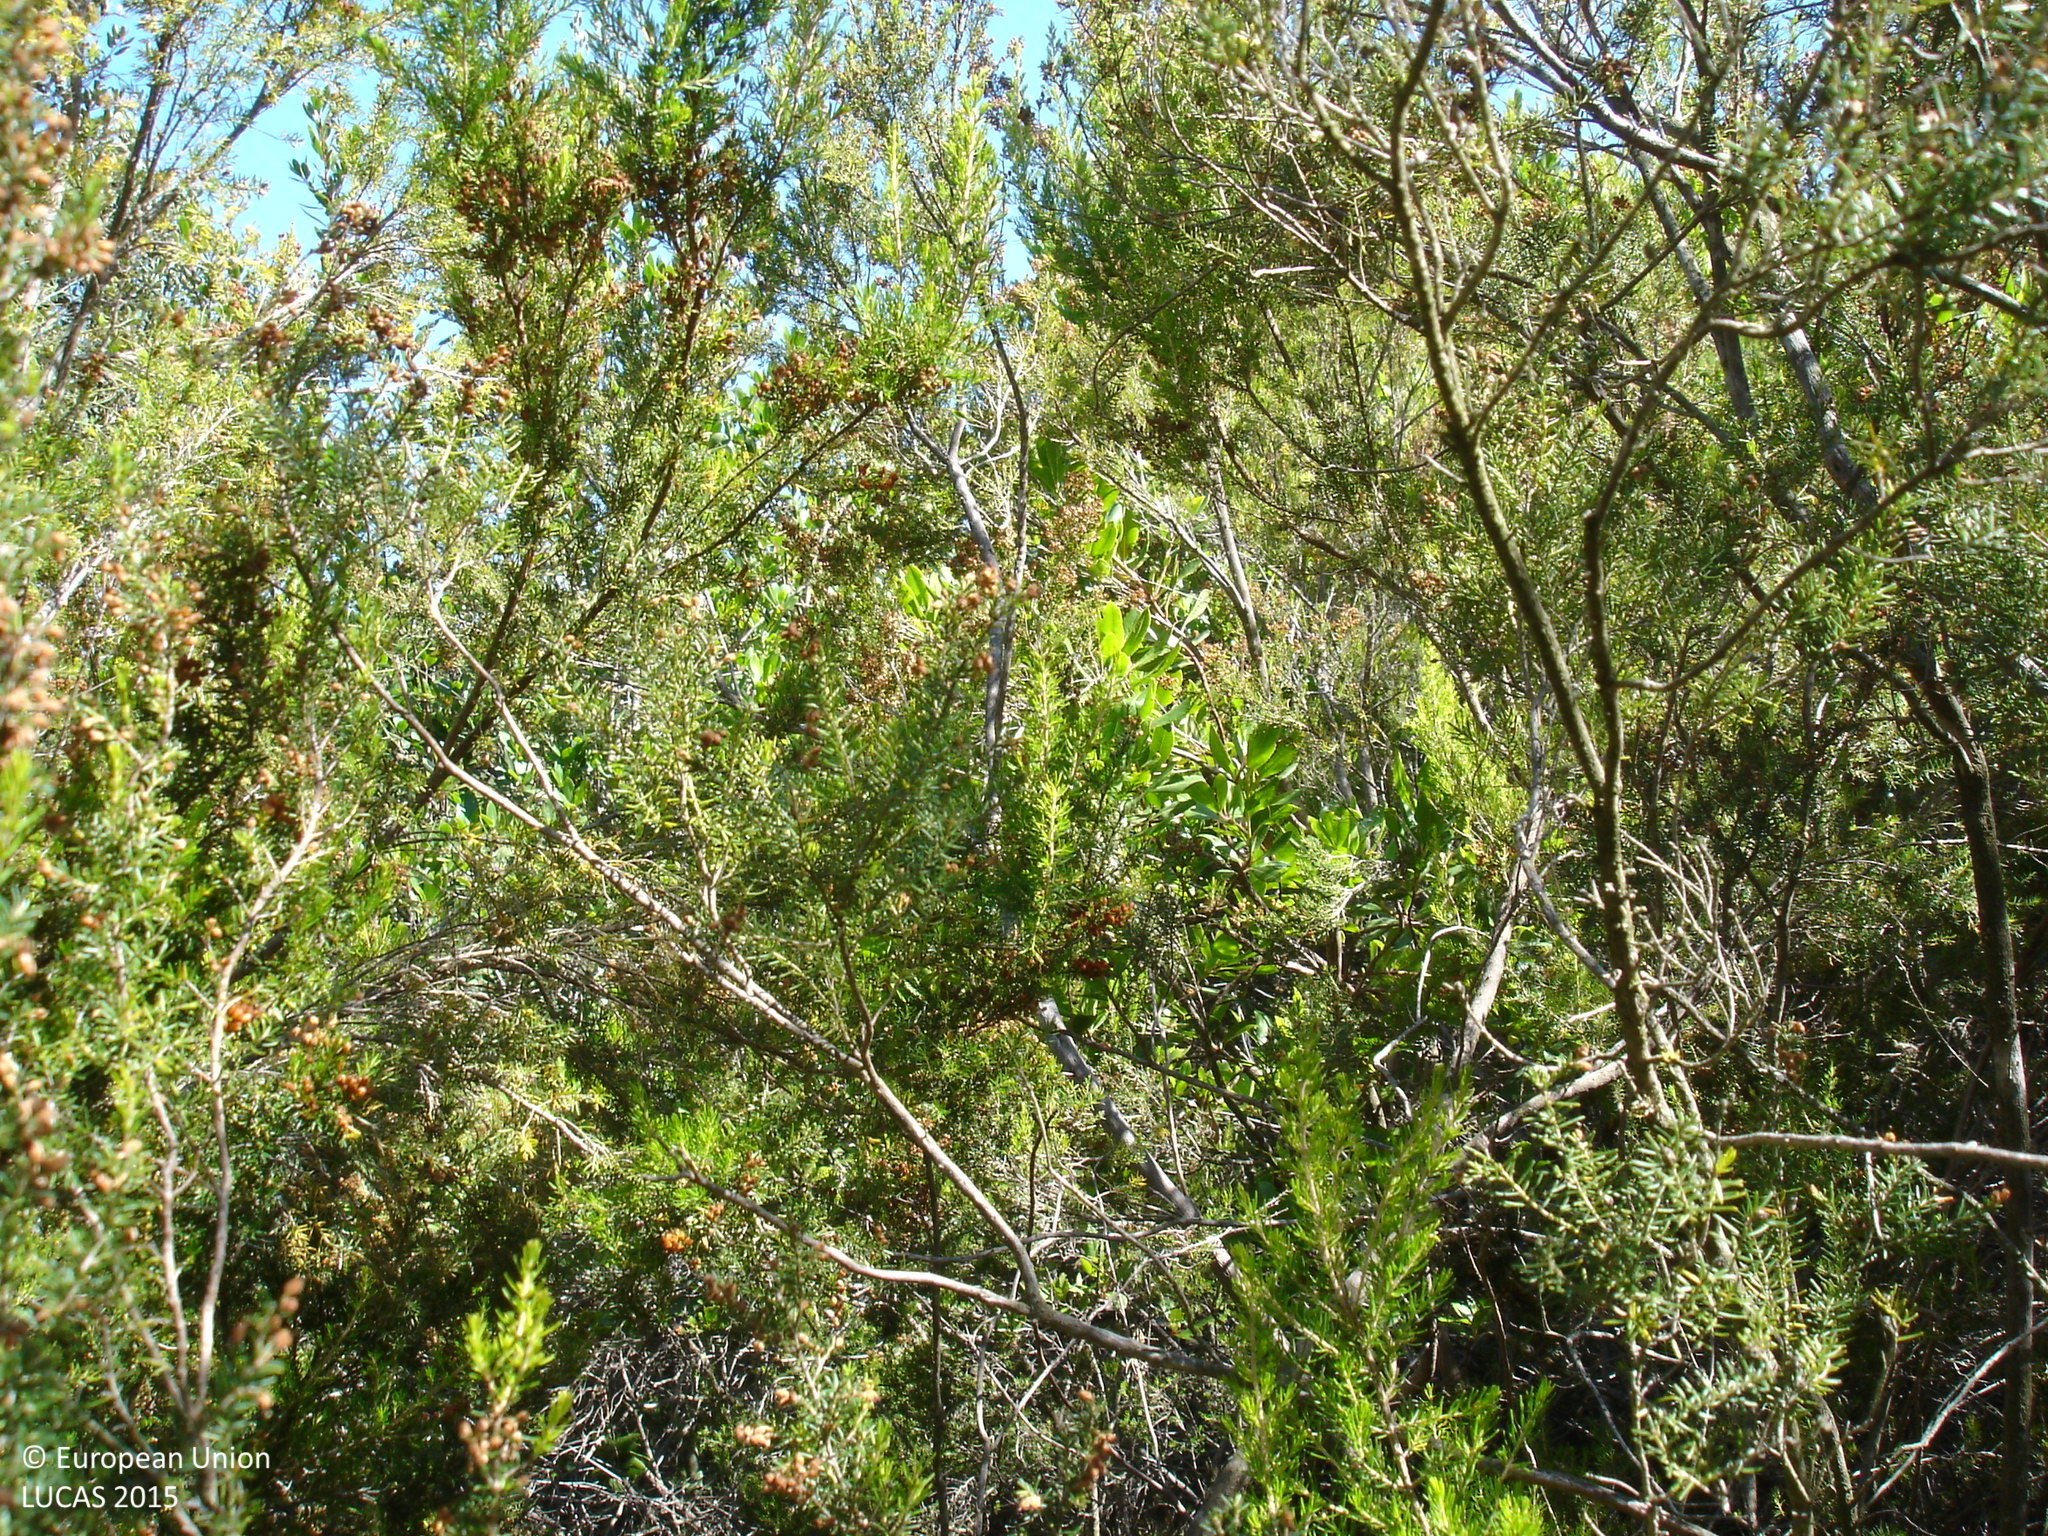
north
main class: Woodland
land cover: Broadleaved woodland
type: thermophilous deciduous forest
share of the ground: > 75 %
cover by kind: broadleaved forest trees 75 %, herbaceous plants 25 %
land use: Forestry
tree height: > 5 m
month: June
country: ES
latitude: 41.7662
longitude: 2.5947
